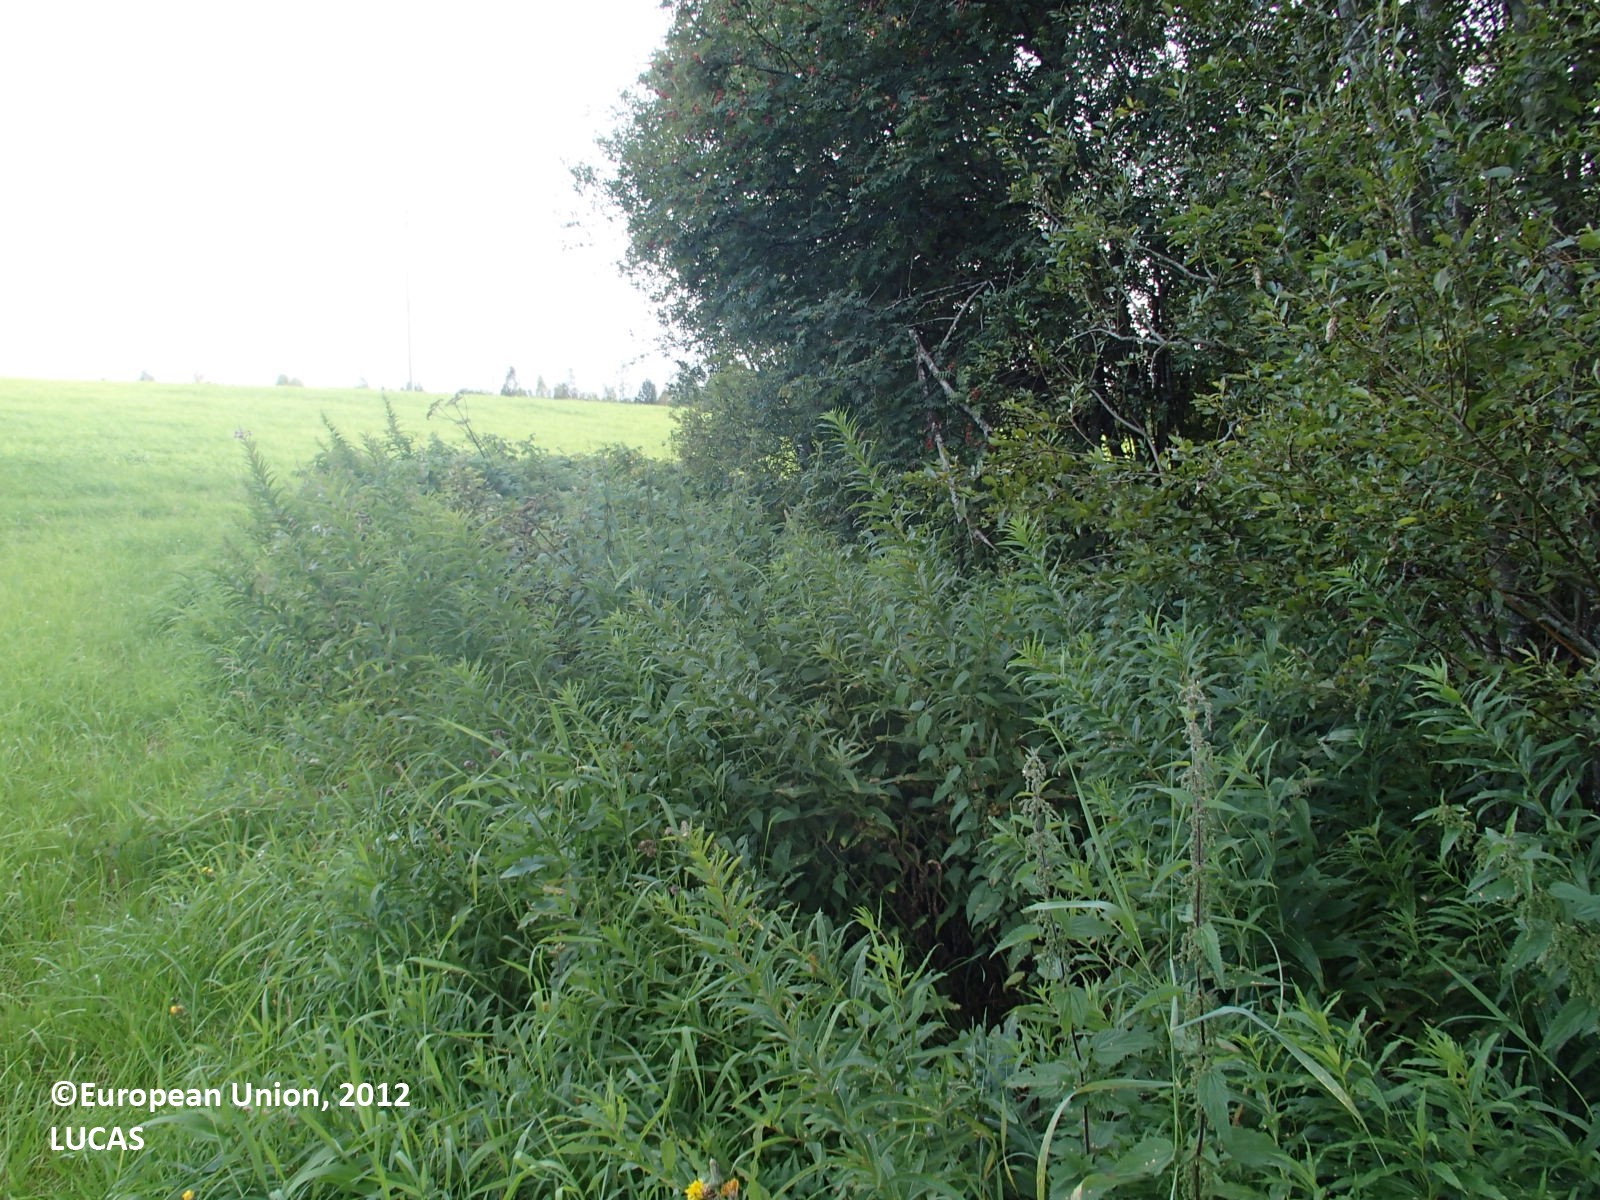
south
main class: Cropland
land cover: Temporary grasslands
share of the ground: > 75 %
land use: Agriculture (excluding fallow land and kitchen gardens)
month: August
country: FI
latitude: 63.4306
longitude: 27.9873
